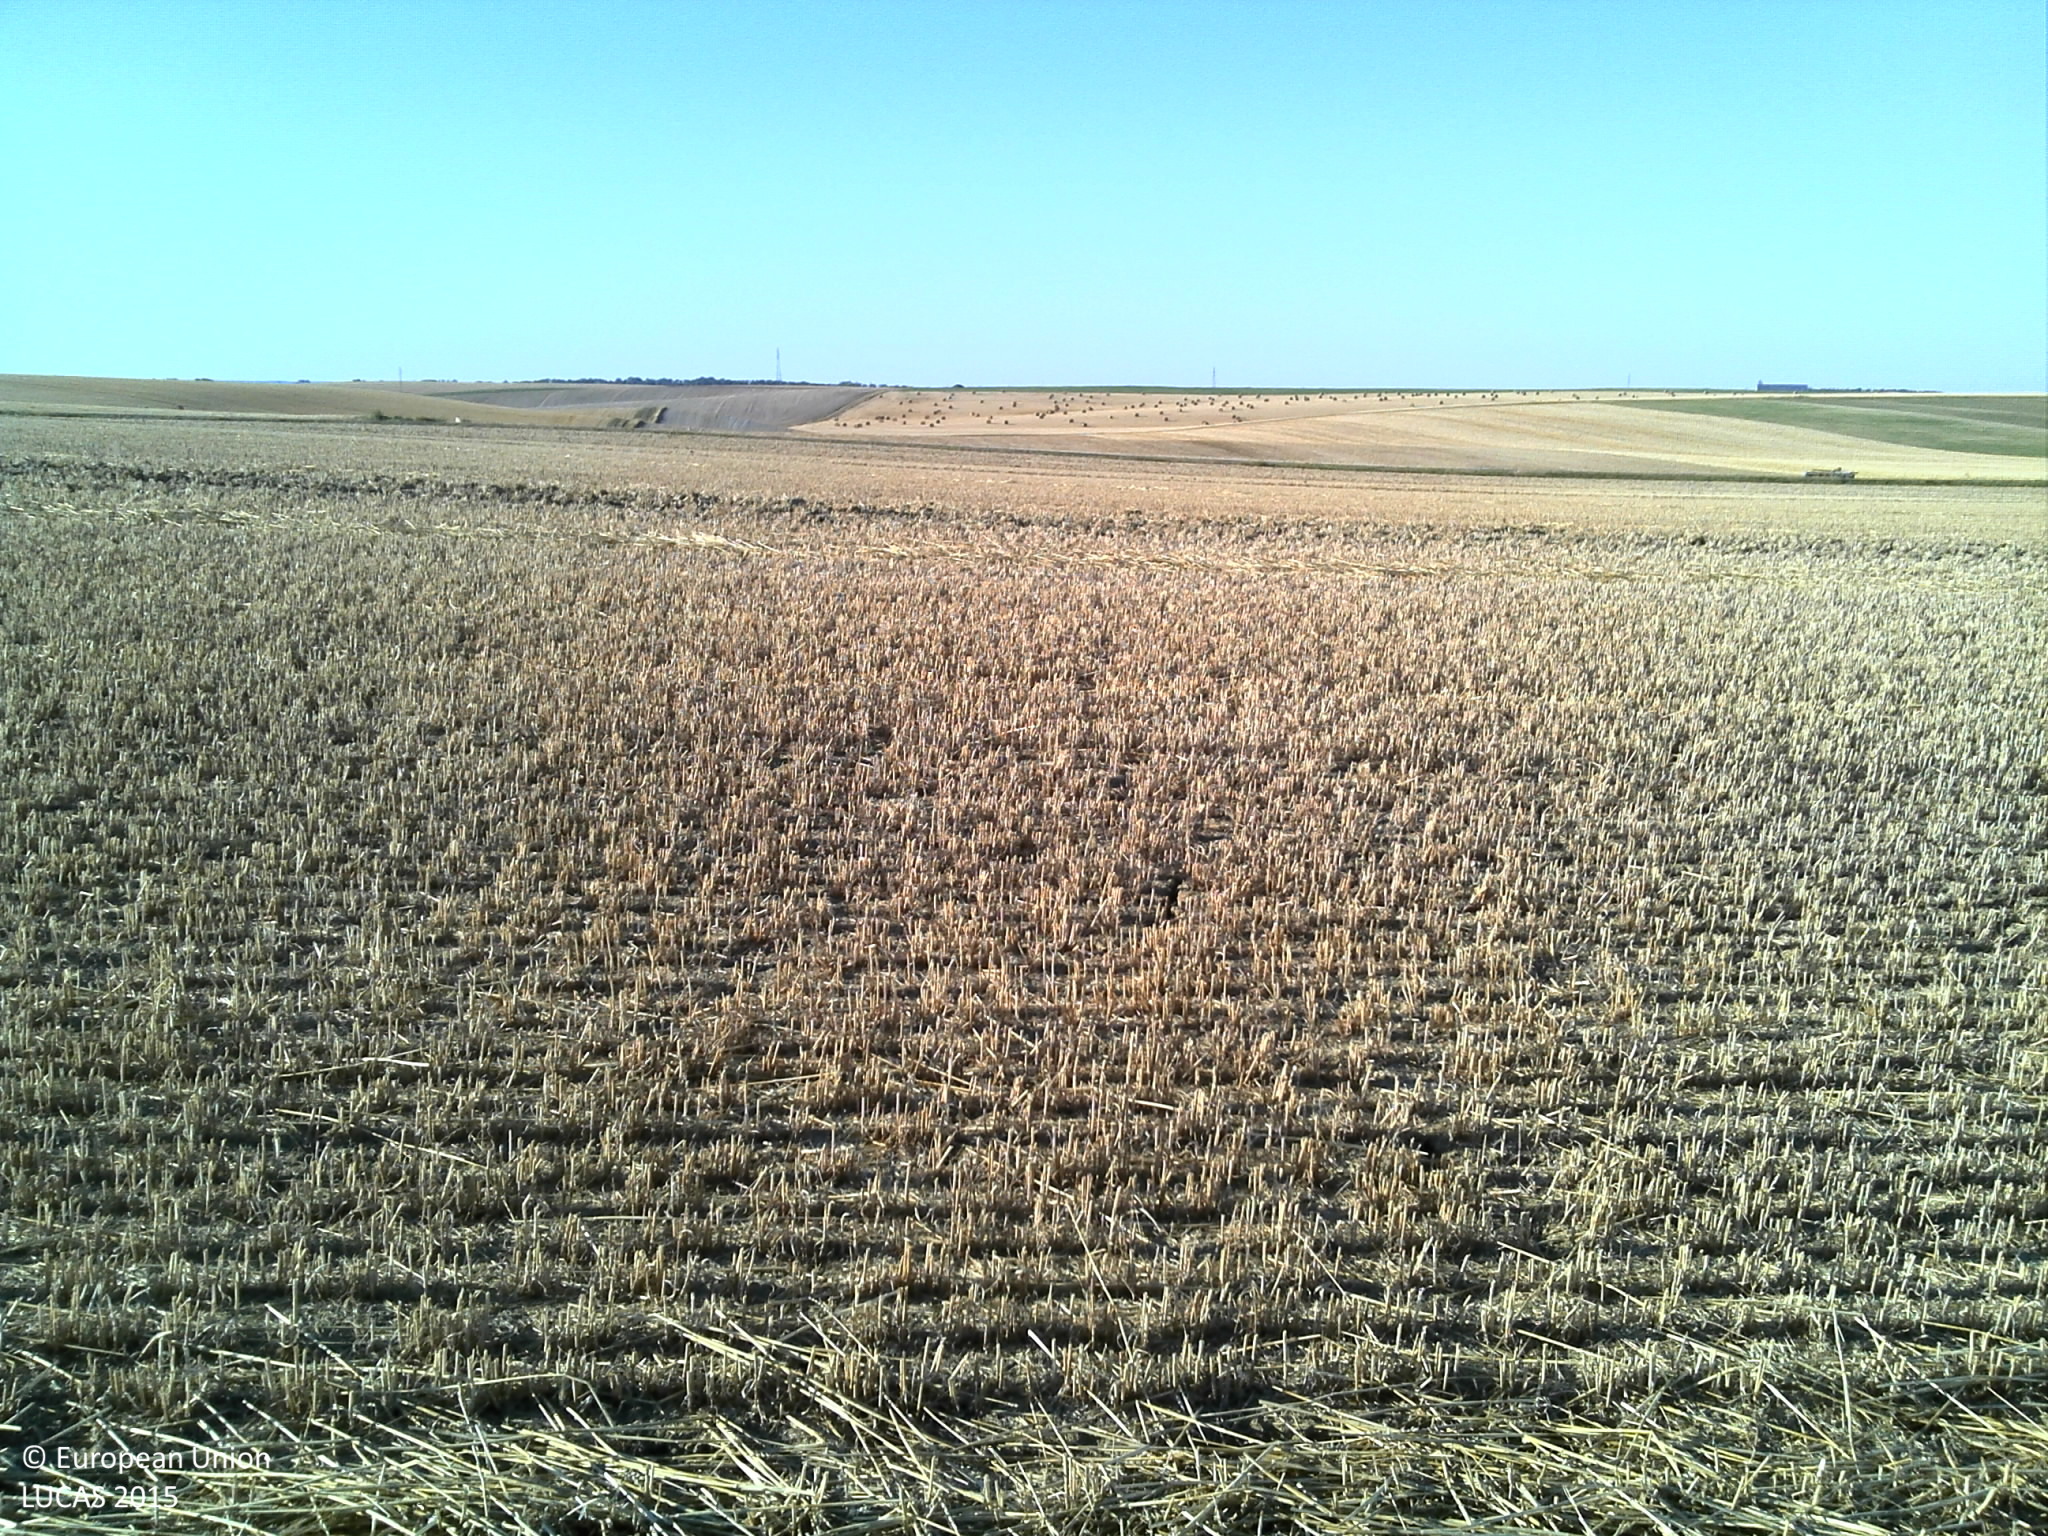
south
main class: Cropland
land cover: Common wheat
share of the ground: > 75 %
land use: Agriculture (excluding fallow land and kitchen gardens)
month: August
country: FR
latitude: 49.1107
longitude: 4.8053
